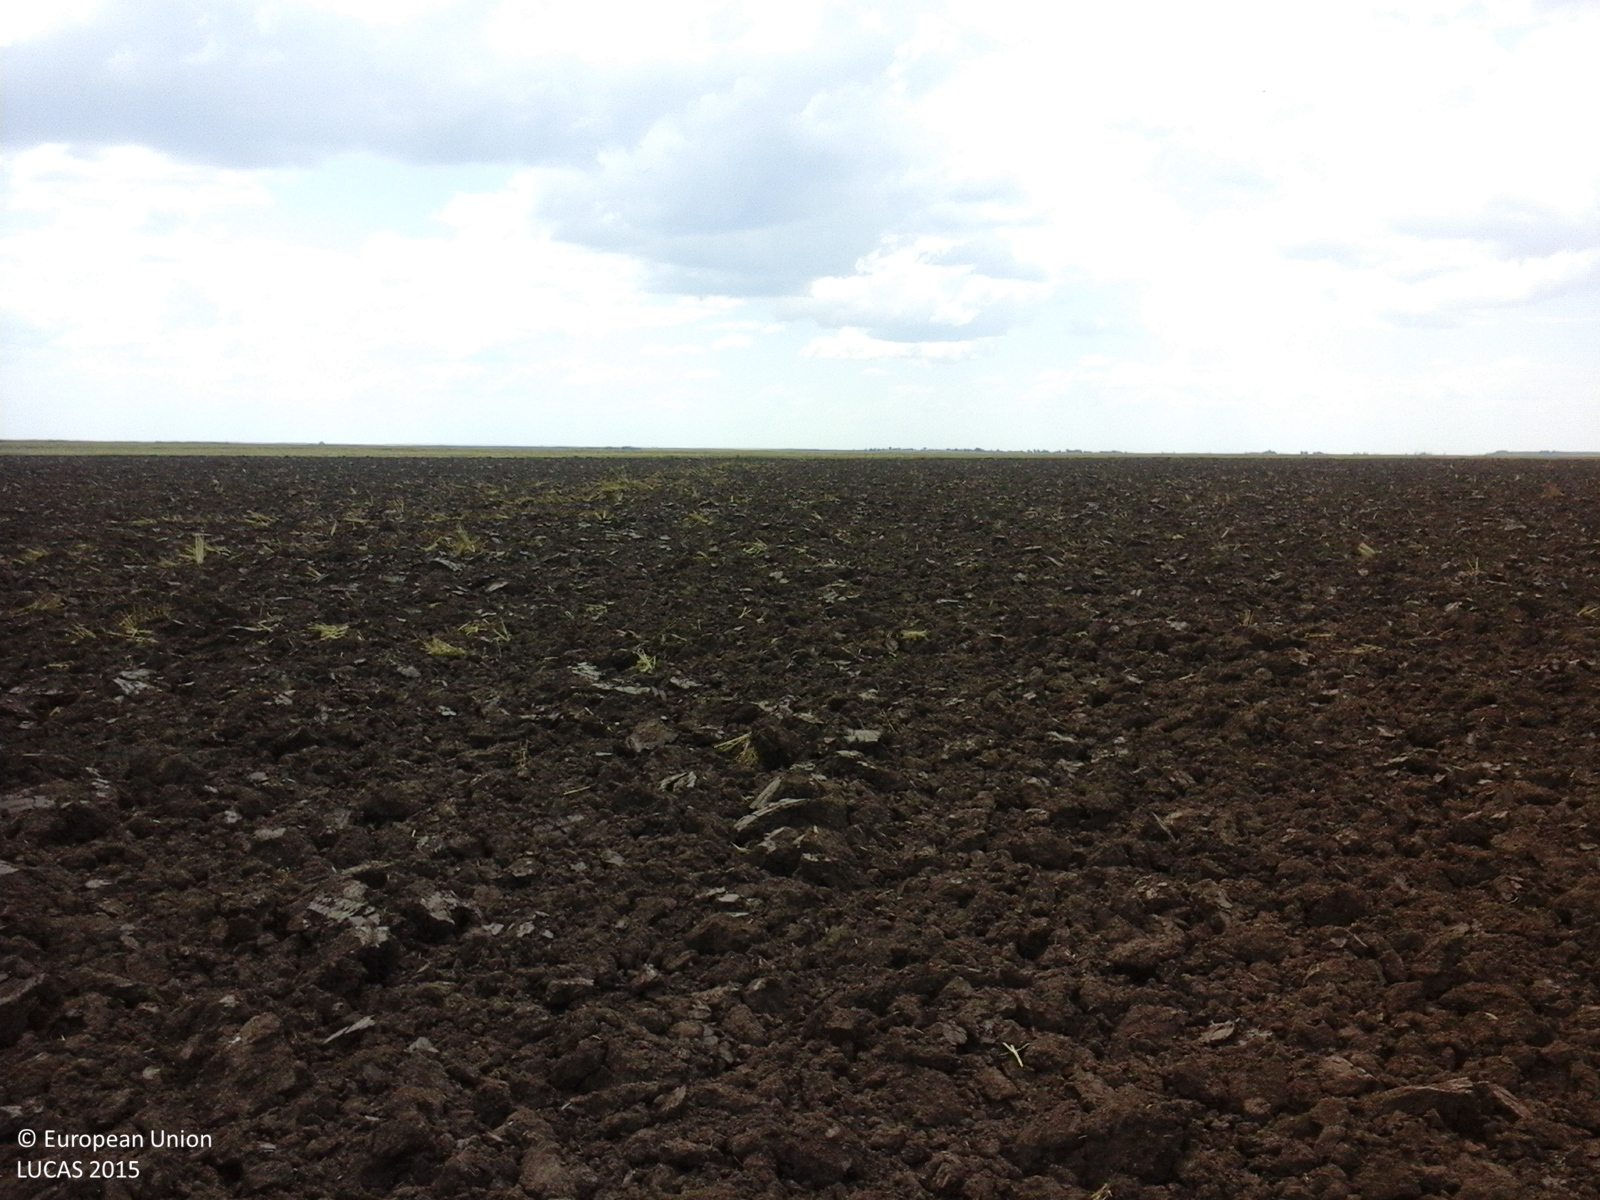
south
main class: Cropland
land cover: Common wheat
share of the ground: < 10 %
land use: Agriculture (excluding fallow land and kitchen gardens)
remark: Harvested field
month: July
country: RO
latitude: 43.9895
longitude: 24.8485
